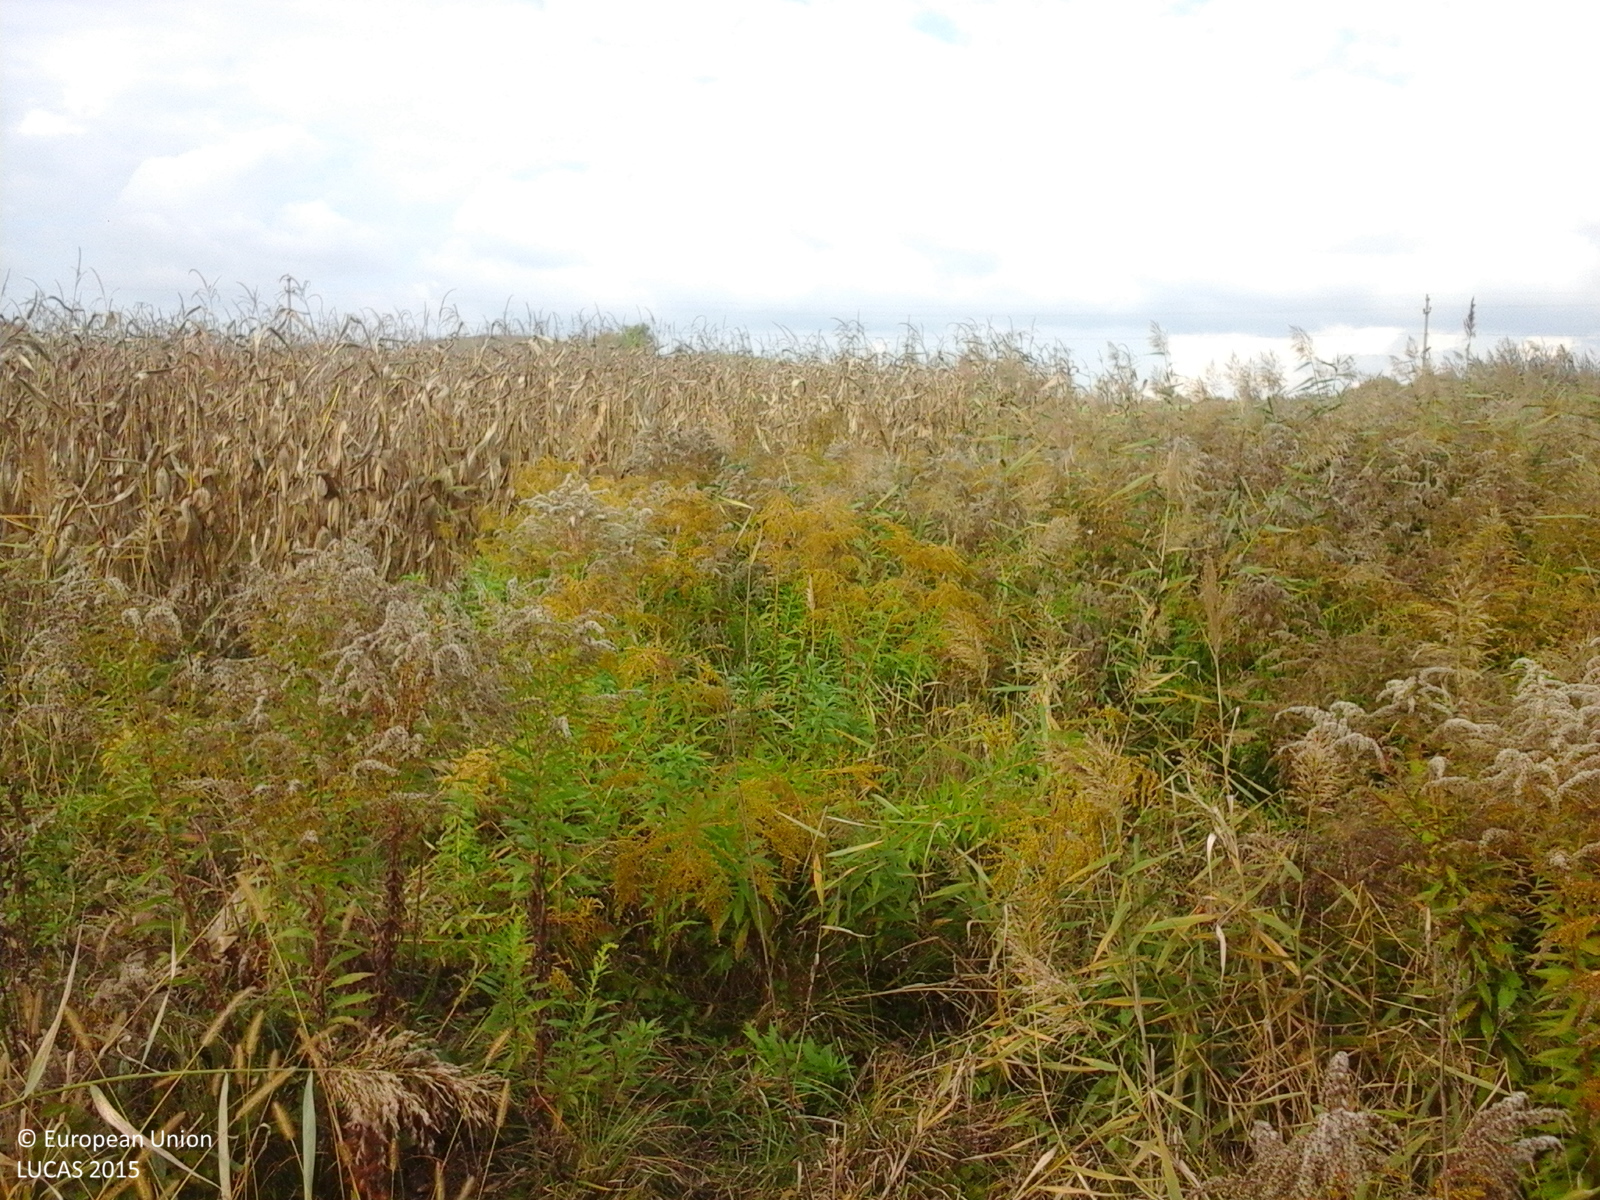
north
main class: Grassland
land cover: Spontaneously vegetated surfaces
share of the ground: > 75 %
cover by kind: herbaceous plants 100 %
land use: Fallow land
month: October
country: RO
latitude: 46.2105
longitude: 24.2732
